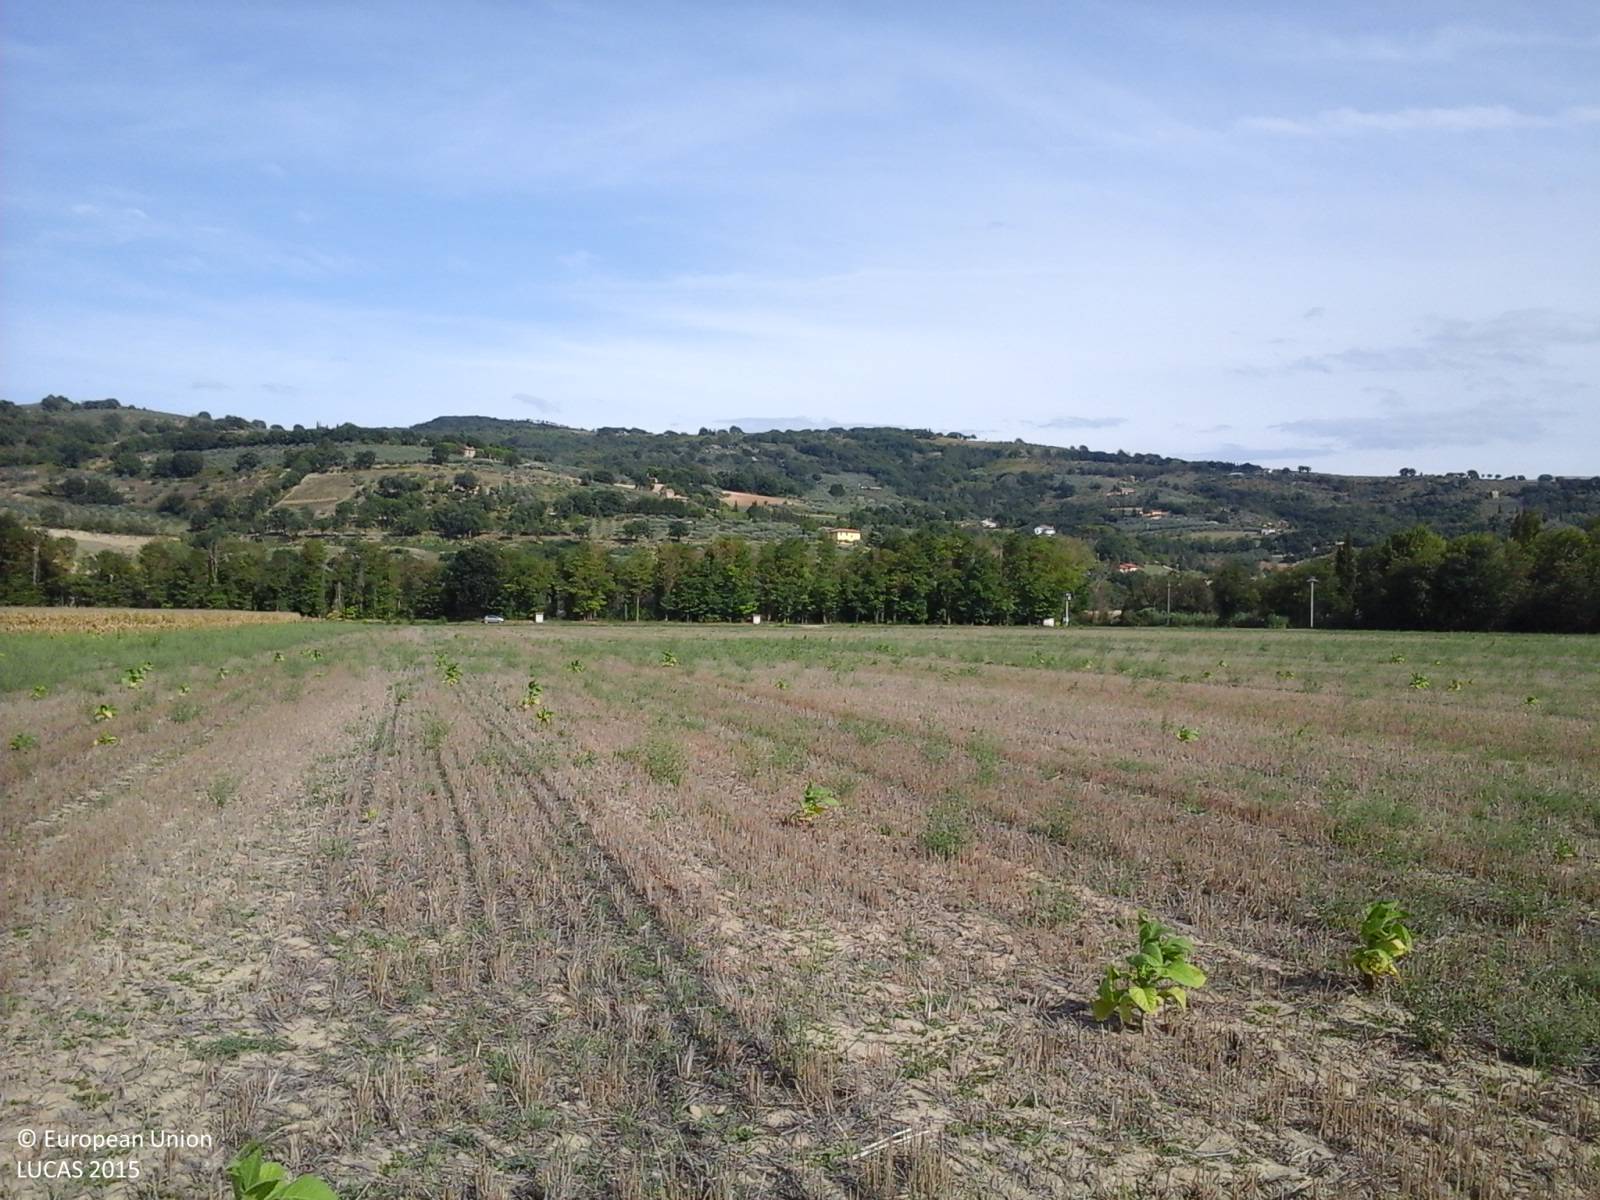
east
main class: Cropland
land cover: Durum wheat
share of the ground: < 10 %
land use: Agriculture (excluding fallow land and kitchen gardens)
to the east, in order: Durum wheat
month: September
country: IT
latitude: 43.1281
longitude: 12.5373
